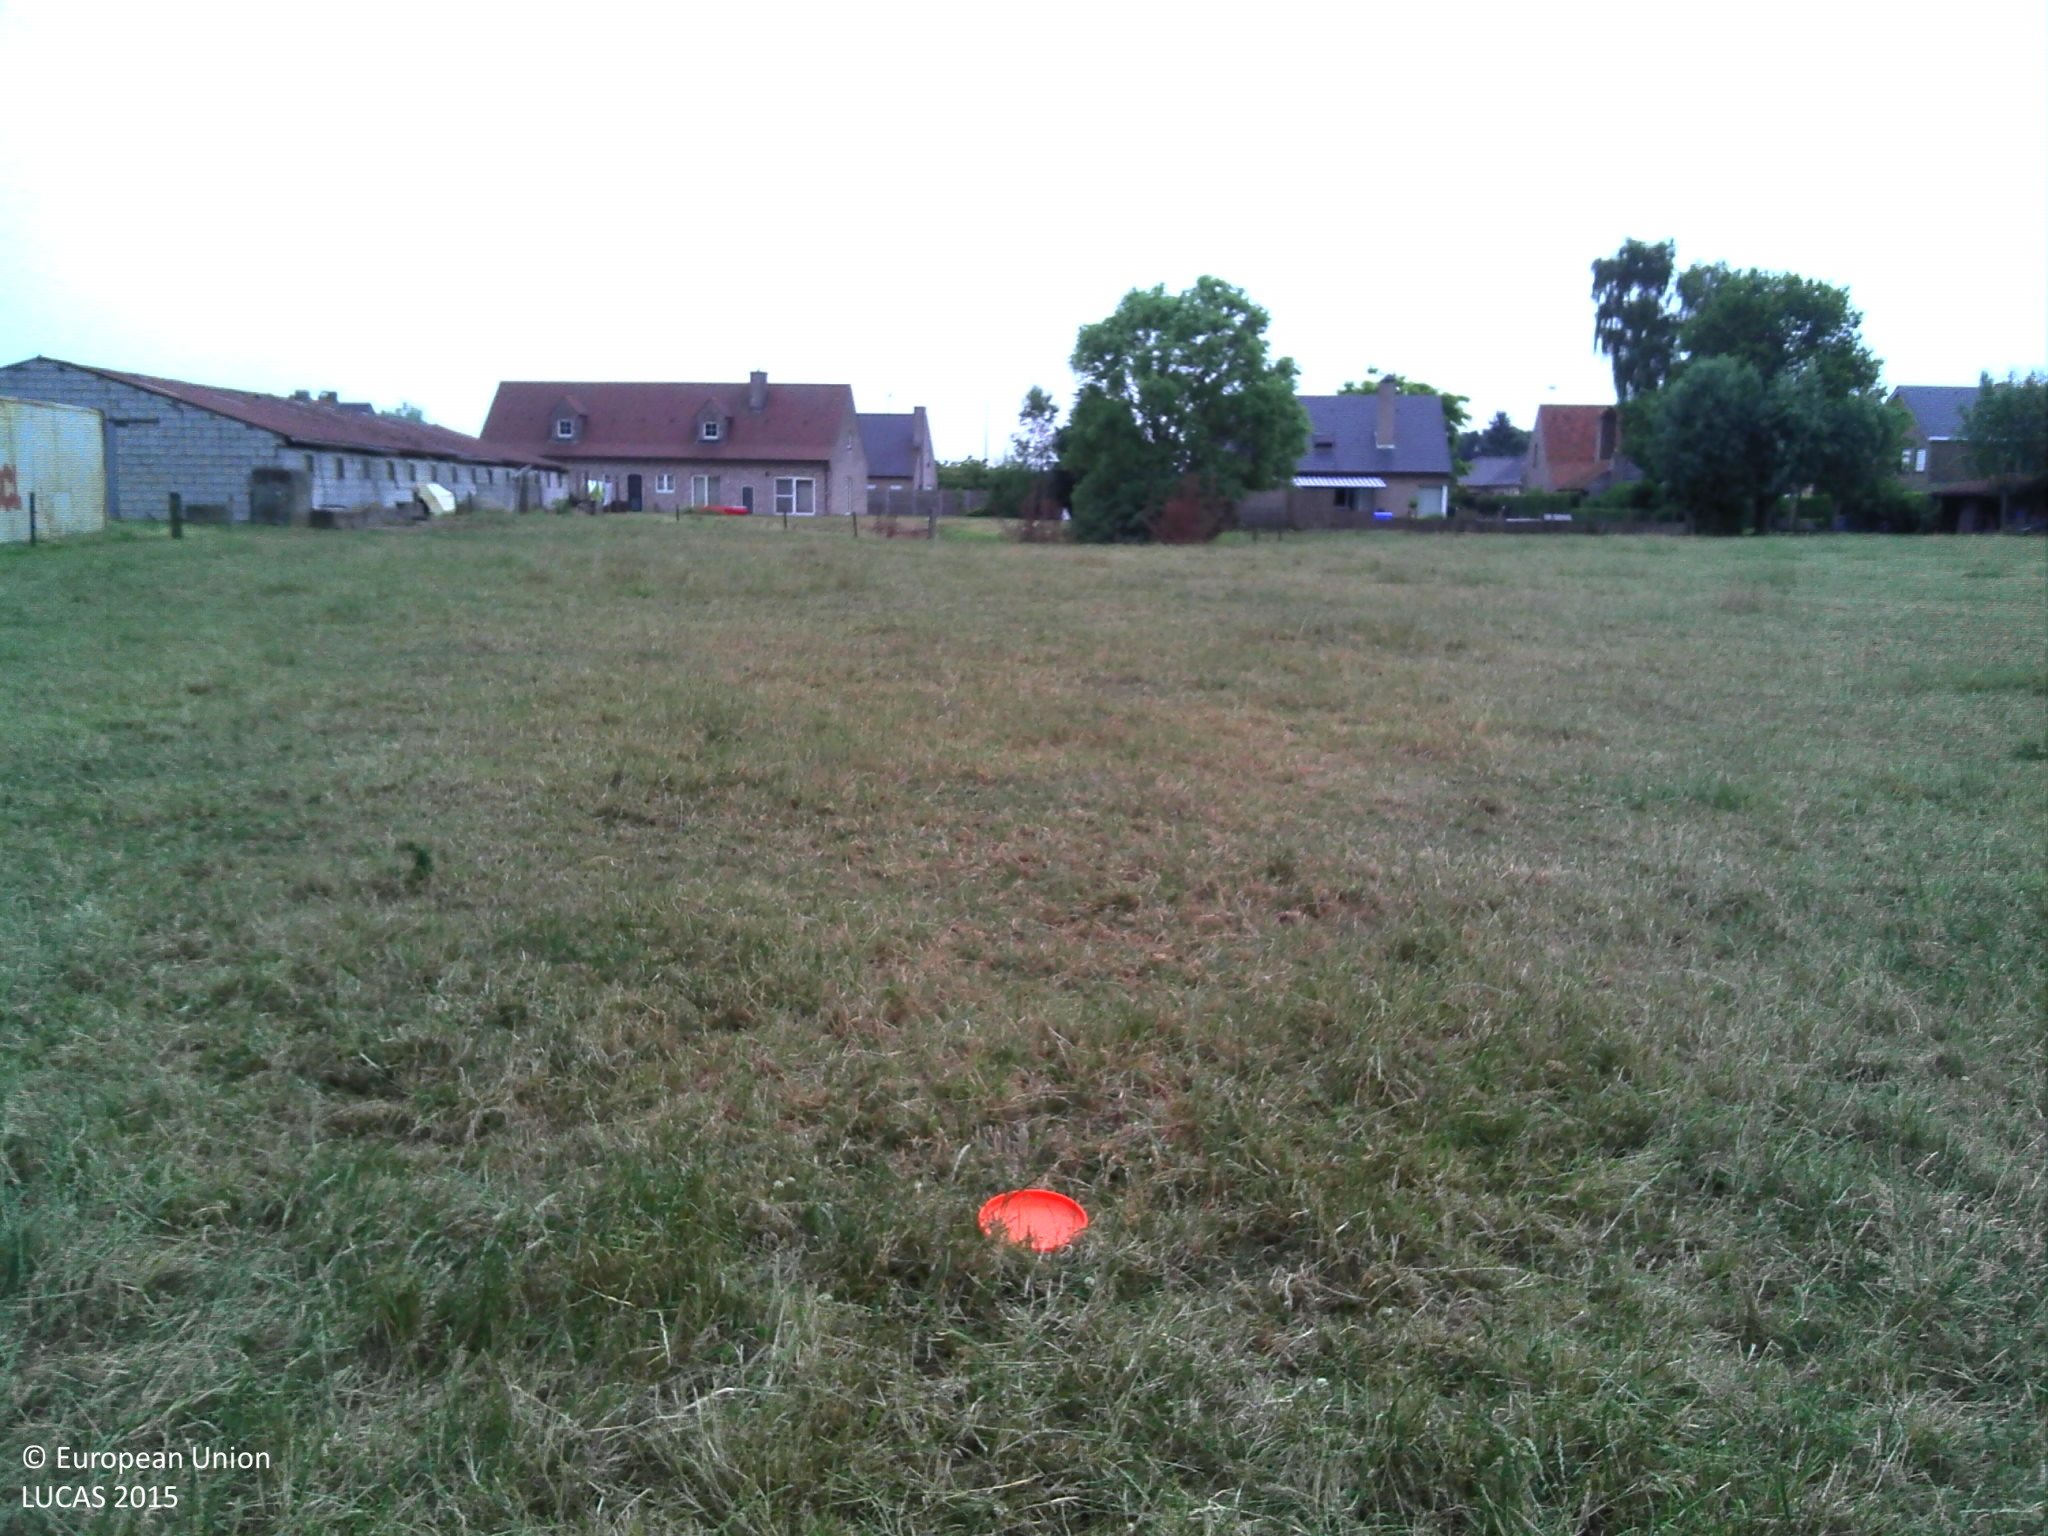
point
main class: Grassland
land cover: Grassland without tree/shrub cover
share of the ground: > 75 %
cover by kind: herbaceous plants 100 %
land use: Agriculture (excluding fallow land and kitchen gardens)
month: July
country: BE
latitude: 51.2452
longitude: 3.5315
